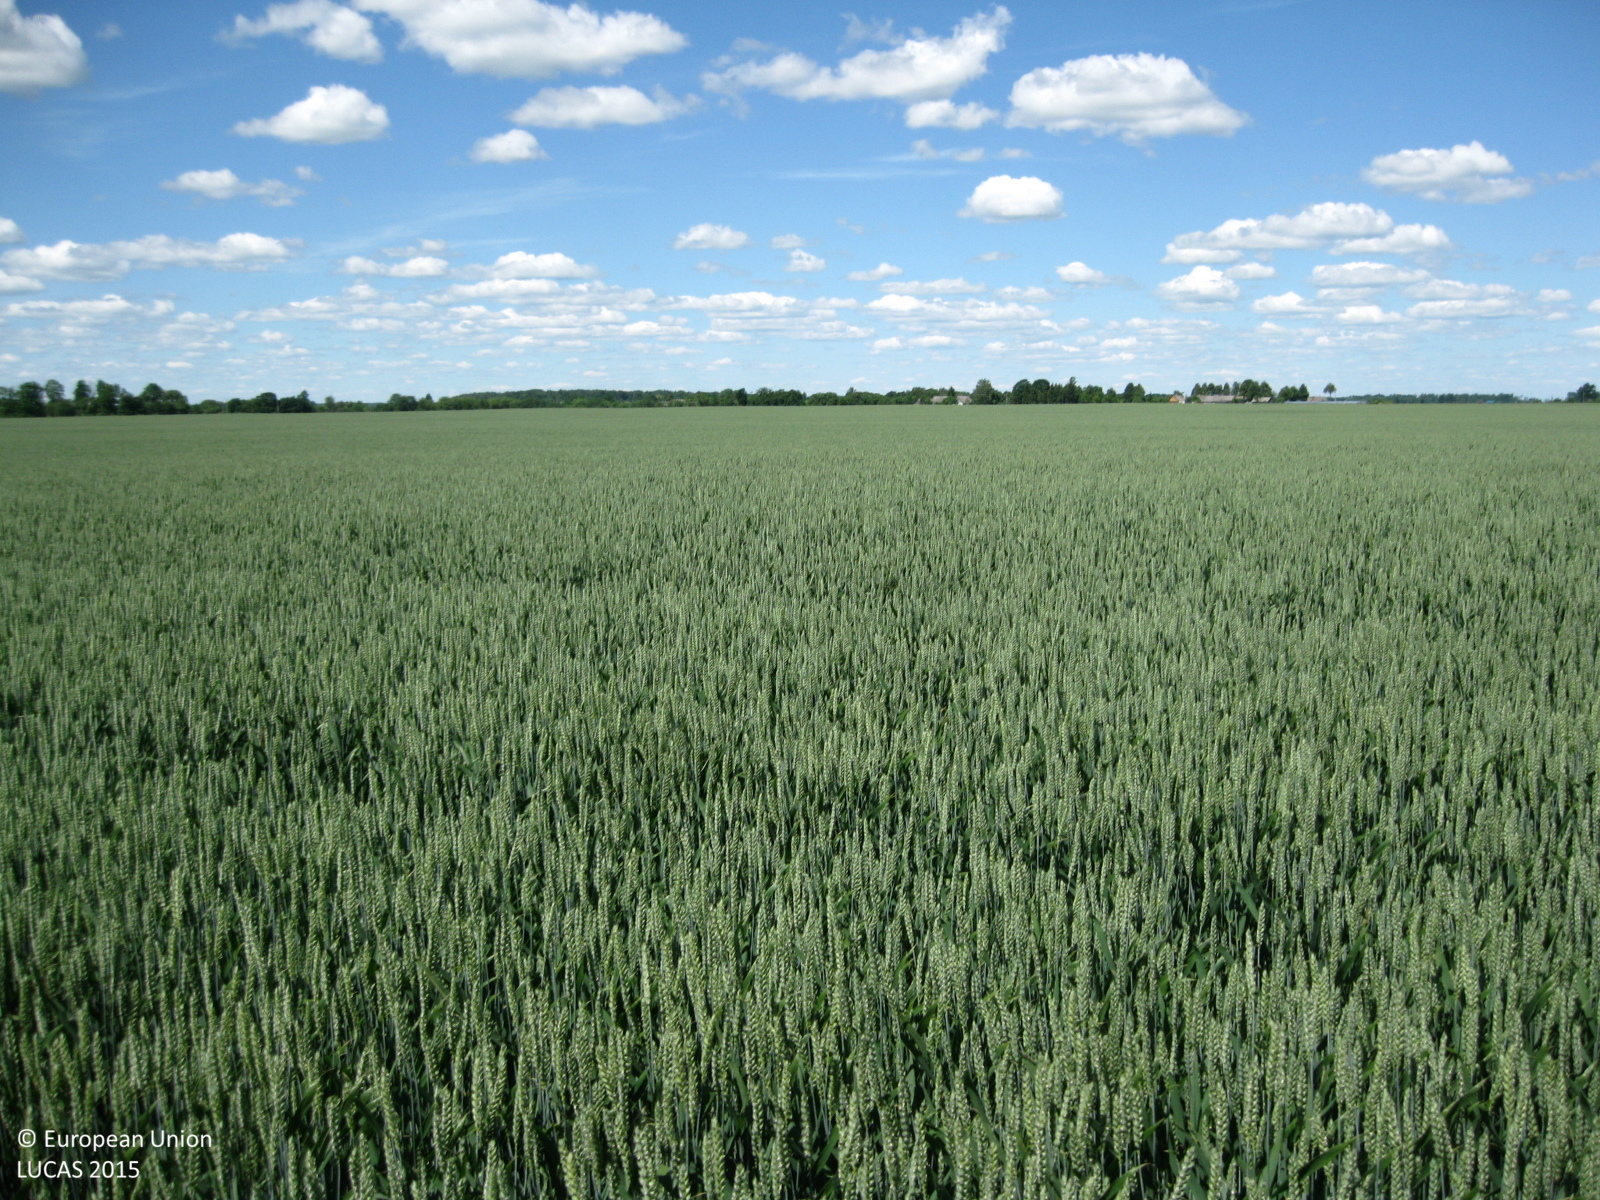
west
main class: Cropland
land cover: Common wheat
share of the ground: > 75 %
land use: Agriculture (excluding fallow land and kitchen gardens)
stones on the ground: < 10 %
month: June
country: LT
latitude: 55.3157
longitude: 23.9068
